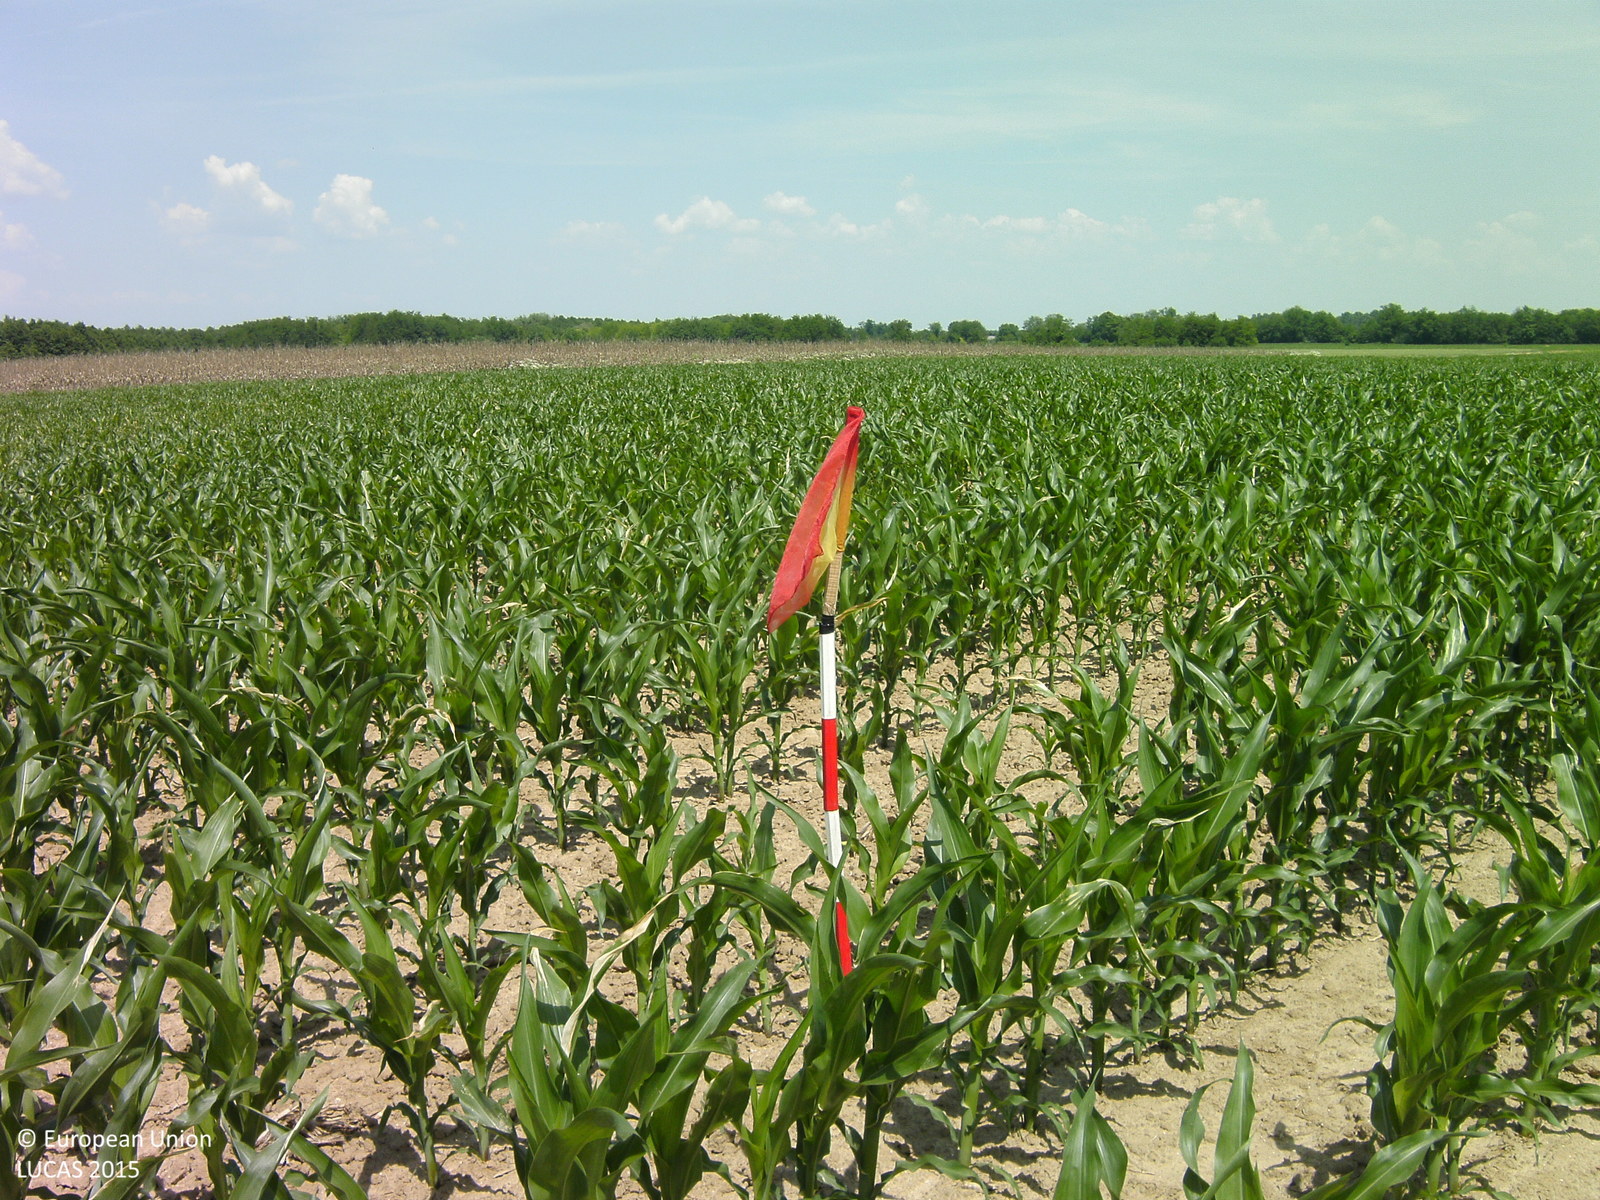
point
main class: Cropland
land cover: Maize
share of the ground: 25 - 50 %
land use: Agriculture (excluding fallow land and kitchen gardens)
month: June
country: HU
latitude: 46.3996
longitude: 17.6923
